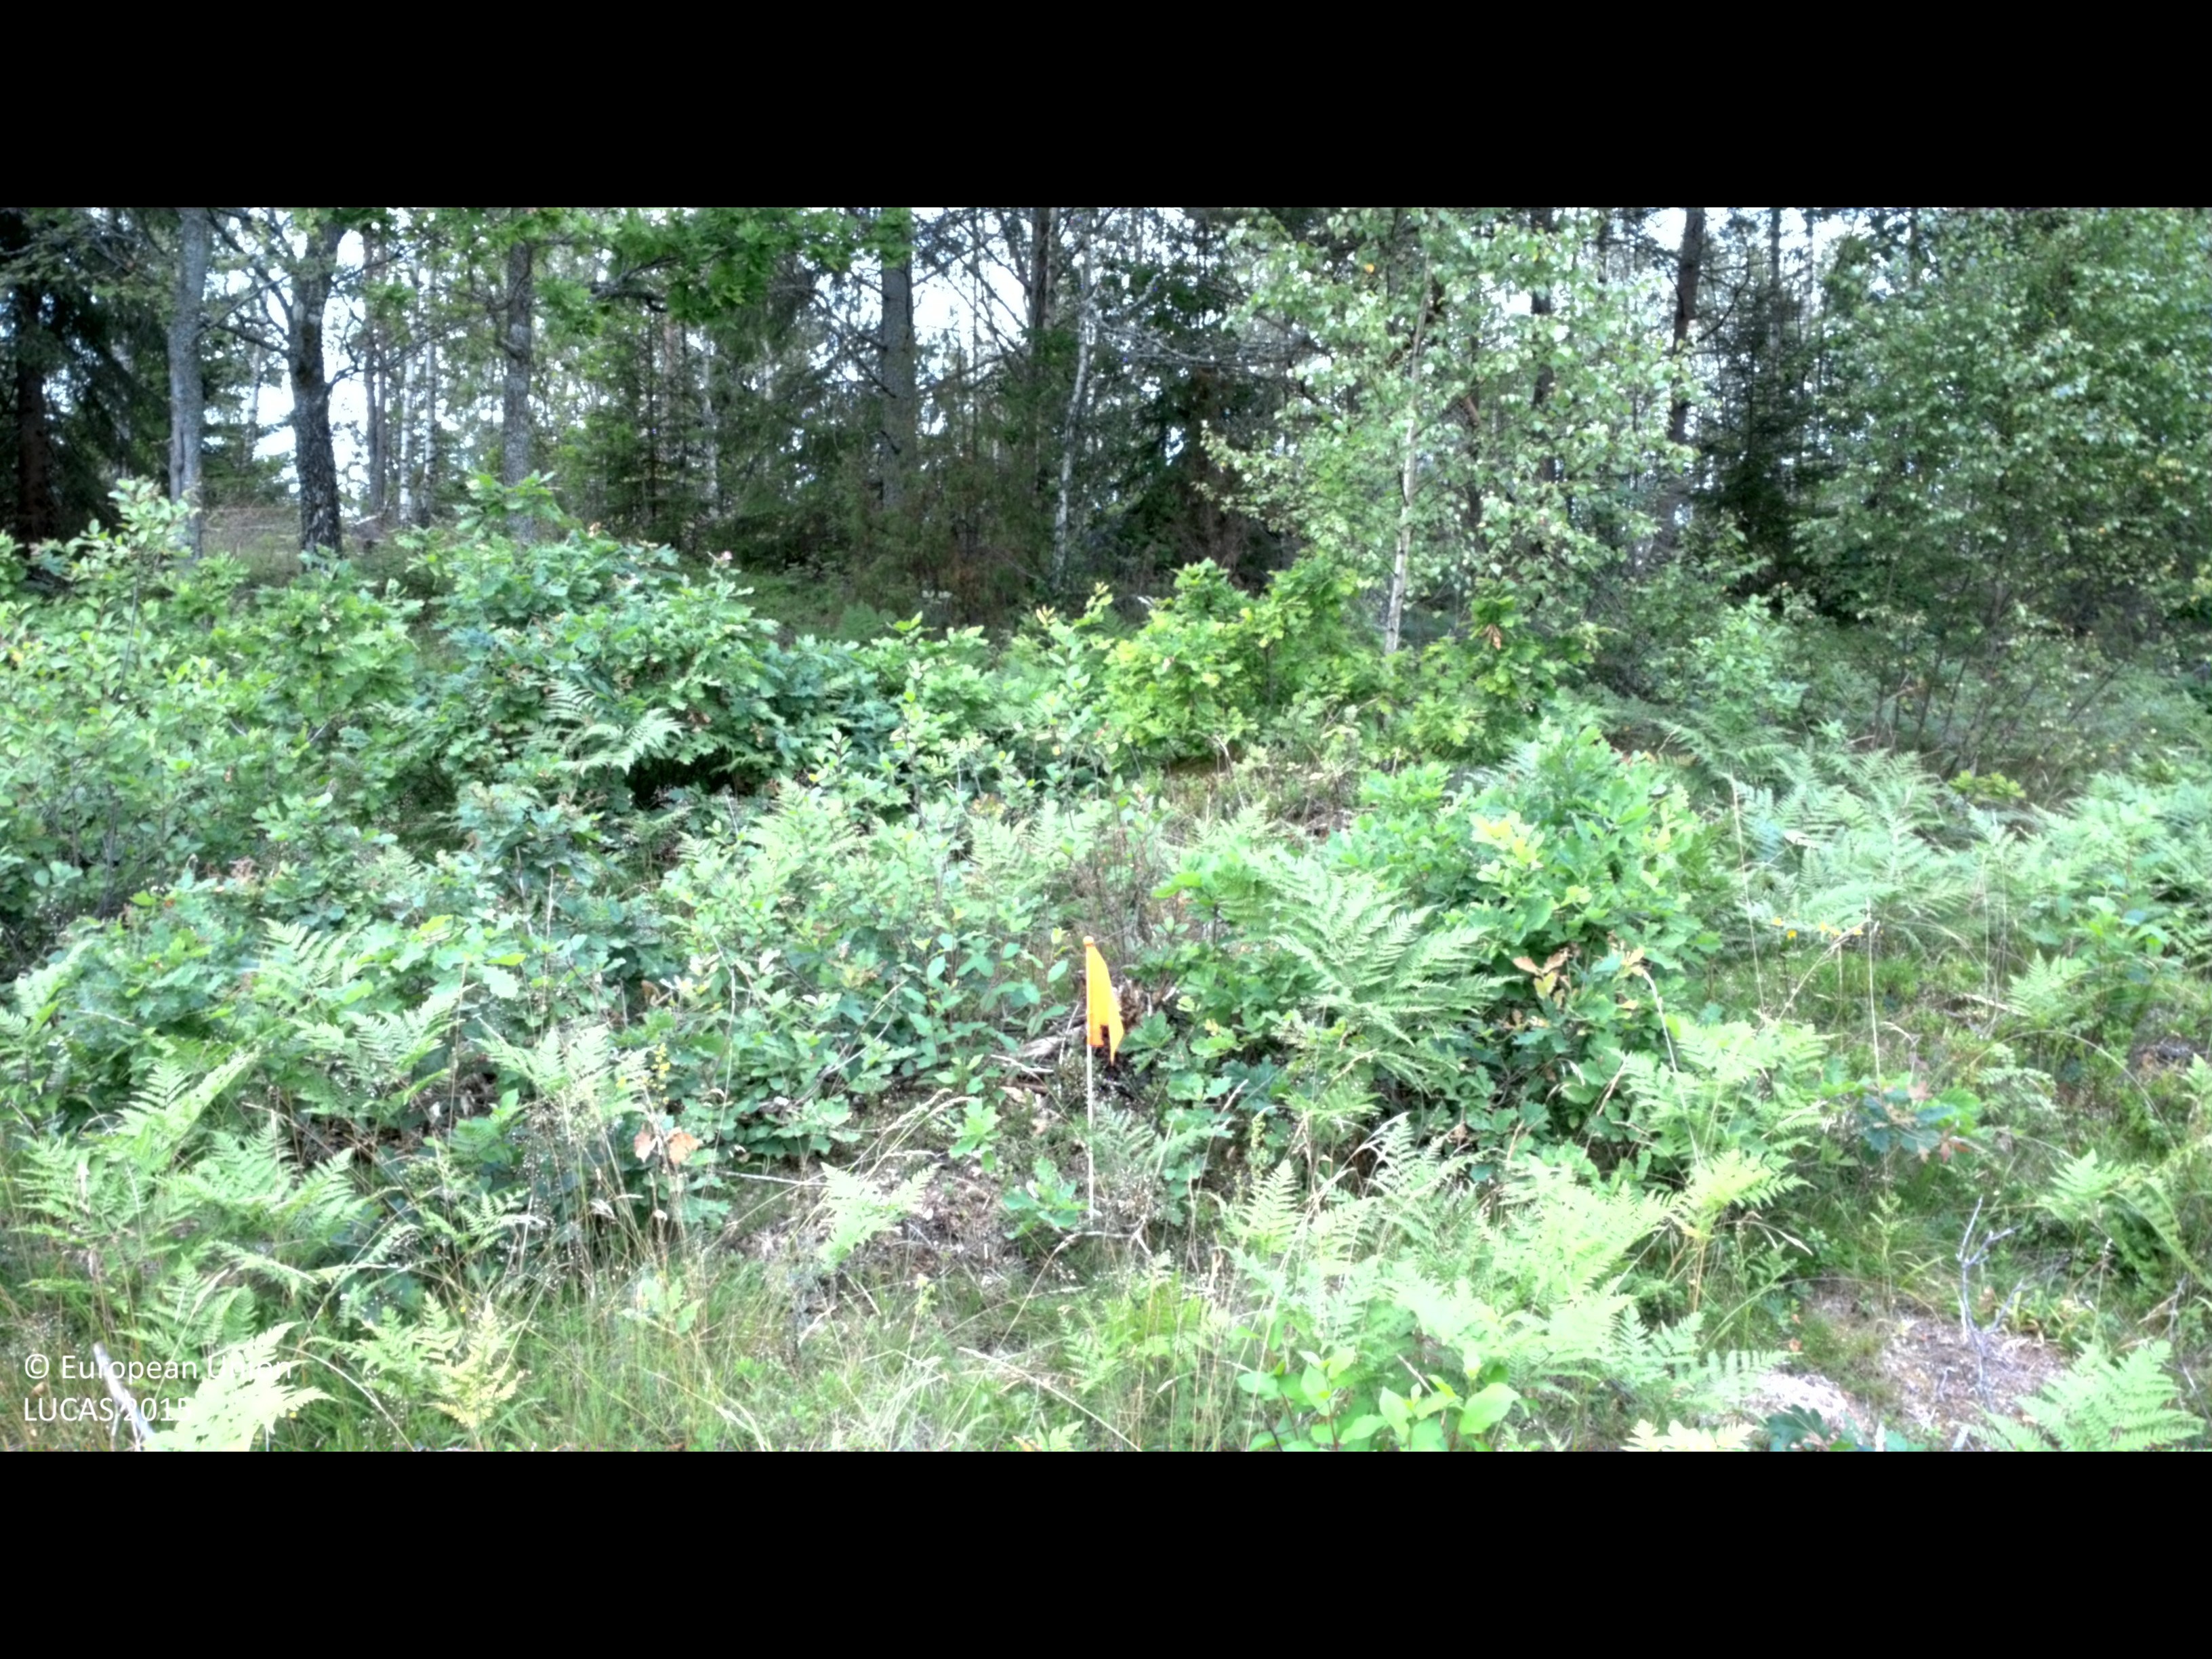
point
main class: Woodland
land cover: Broadleaved woodland
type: boreal forest
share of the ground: 25 - 50 %
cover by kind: herbaceous plants 55 %, broadleaved forest trees 35 %, shrubs 10 %
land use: Forestry
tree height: < 5 m
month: July
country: SE
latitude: 57.8786
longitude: 16.1857
